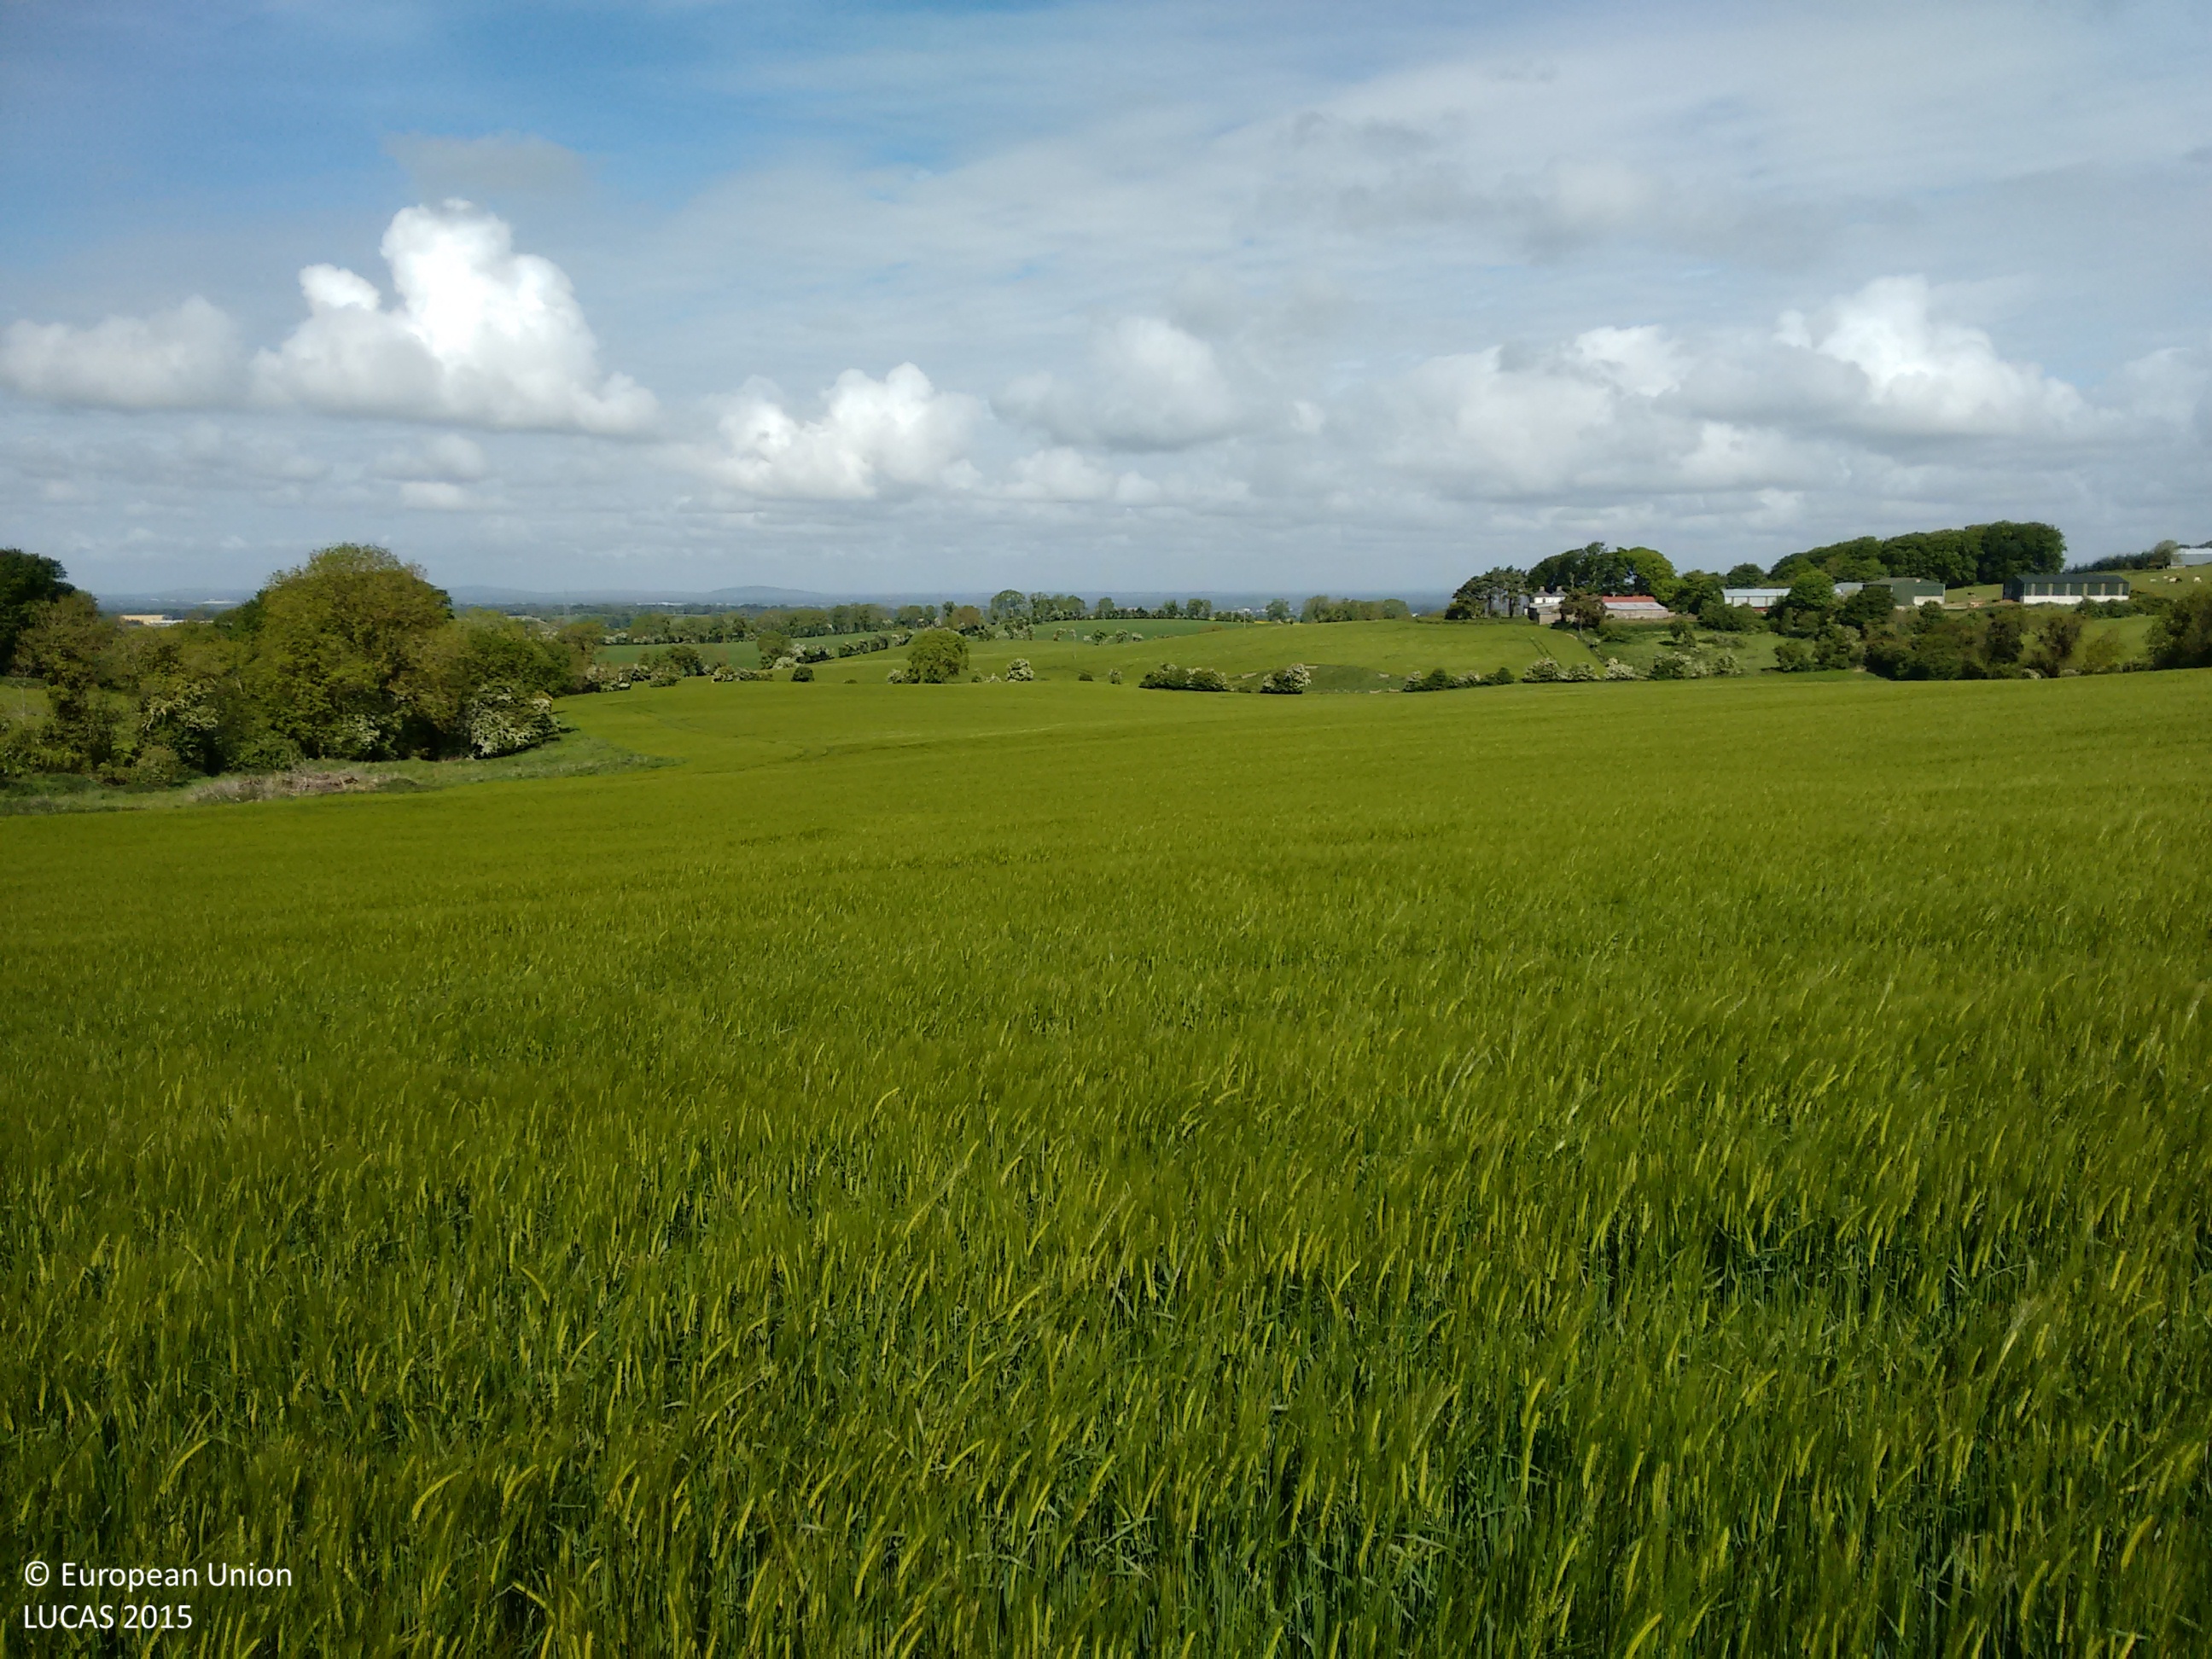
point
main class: Cropland
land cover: Common wheat
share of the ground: > 75 %
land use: Agriculture (excluding fallow land and kitchen gardens)
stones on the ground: < 10 %
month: June
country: IE
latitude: 53.1852
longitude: -6.5756
